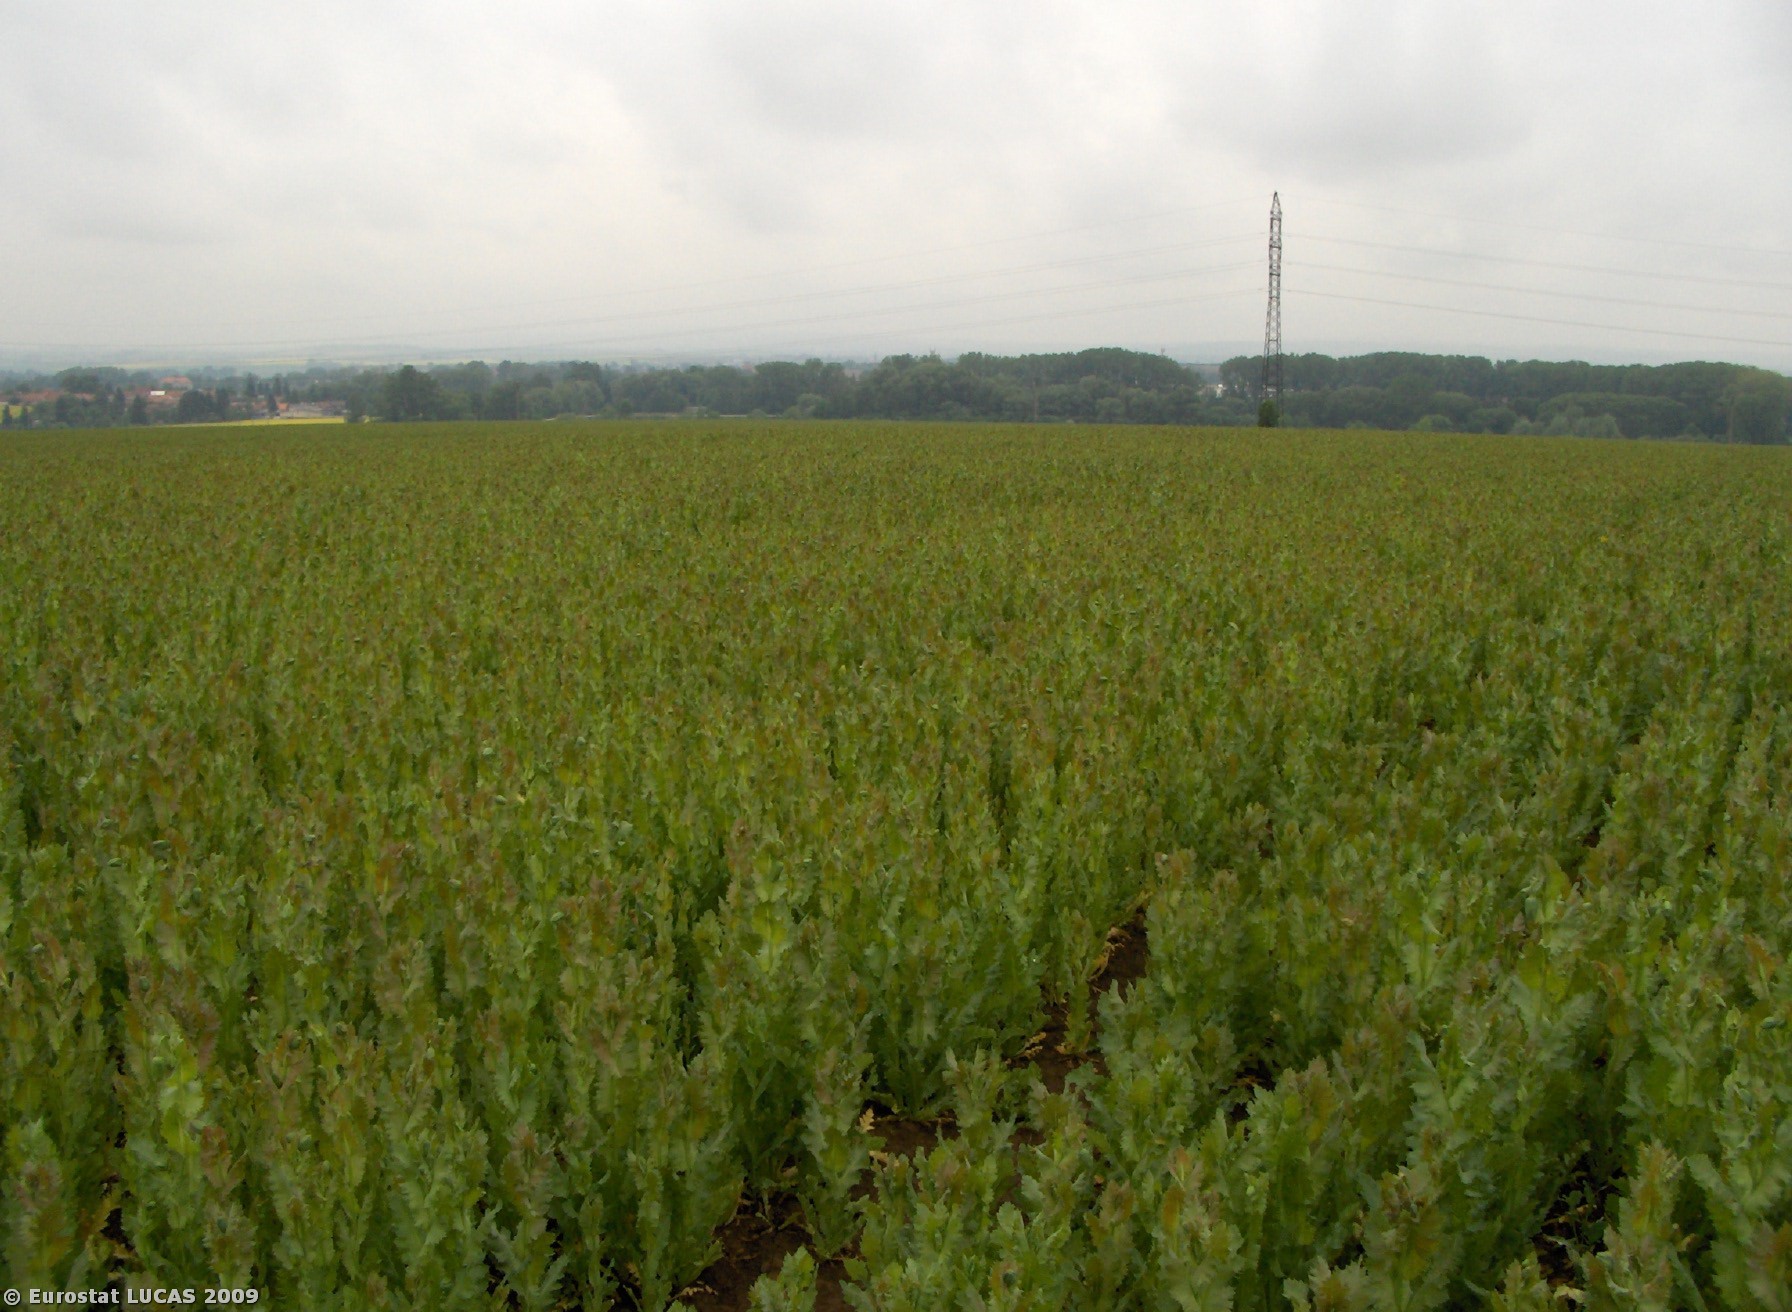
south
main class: Cropland
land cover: Other fibre and oleaginous crops
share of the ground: > 75 %
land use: Agriculture (excluding fallow land and kitchen gardens)
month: May
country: CZ
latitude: 49.3634
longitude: 17.1565
